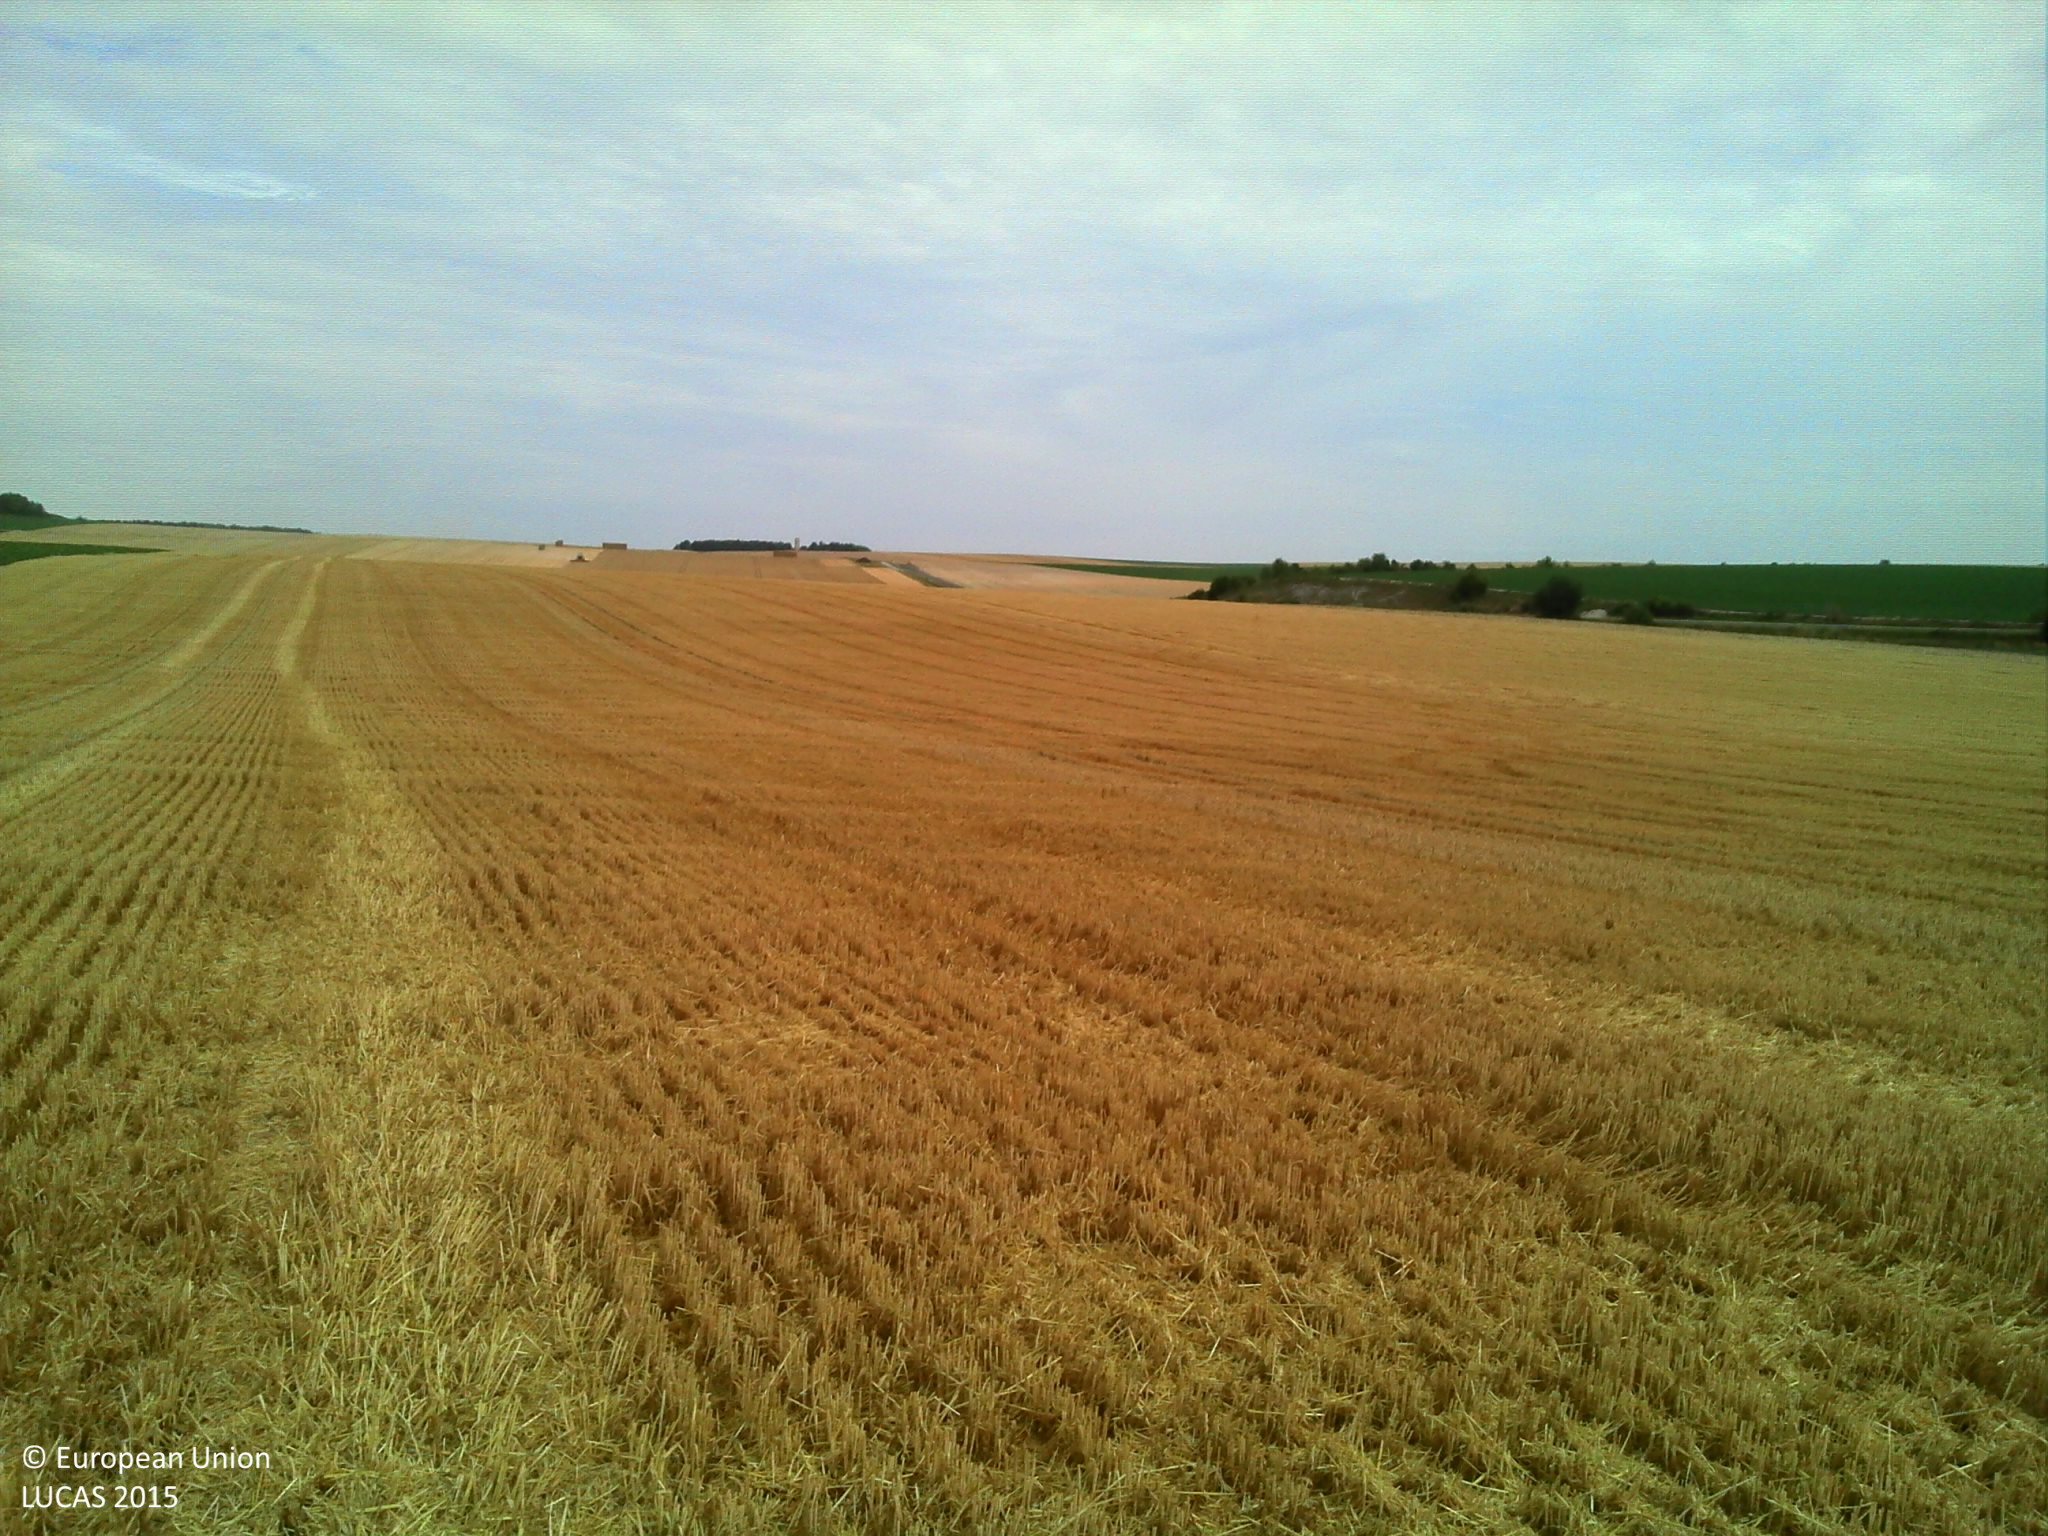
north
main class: Cropland
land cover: Barley
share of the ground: > 75 %
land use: Agriculture (excluding fallow land and kitchen gardens)
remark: Harvested field
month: July
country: FR
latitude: 49.2604
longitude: 4.5414
